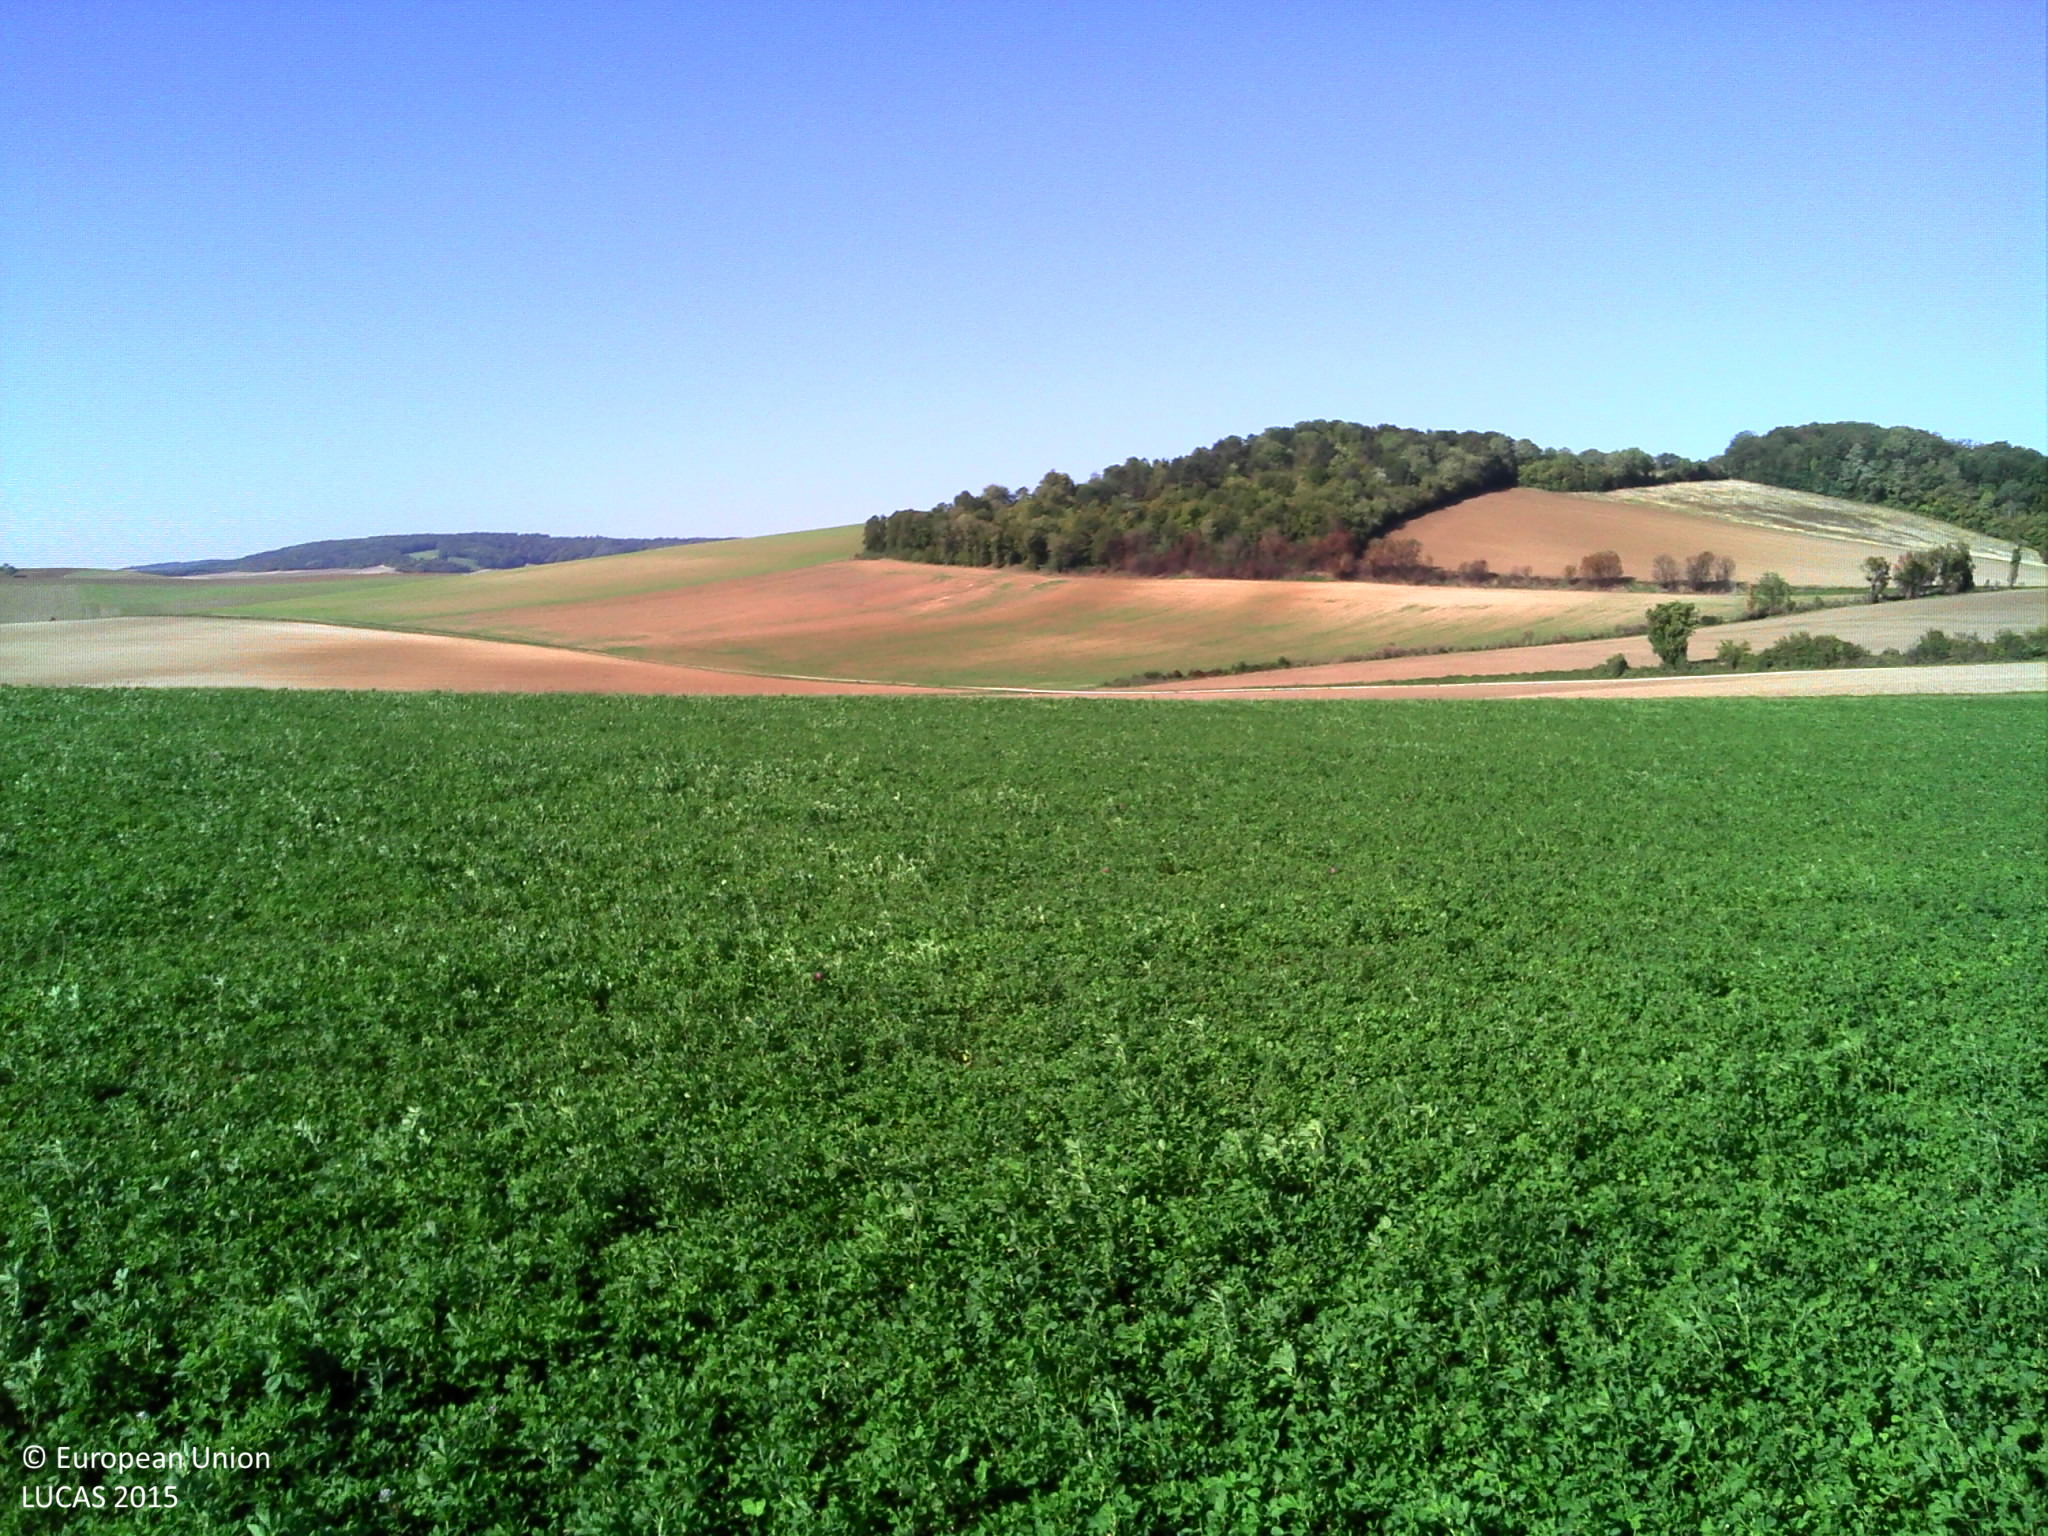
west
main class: Cropland
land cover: Lucerne
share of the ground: > 75 %
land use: Agriculture (excluding fallow land and kitchen gardens)
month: September
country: FR
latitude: 48.1079
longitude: 3.8852
